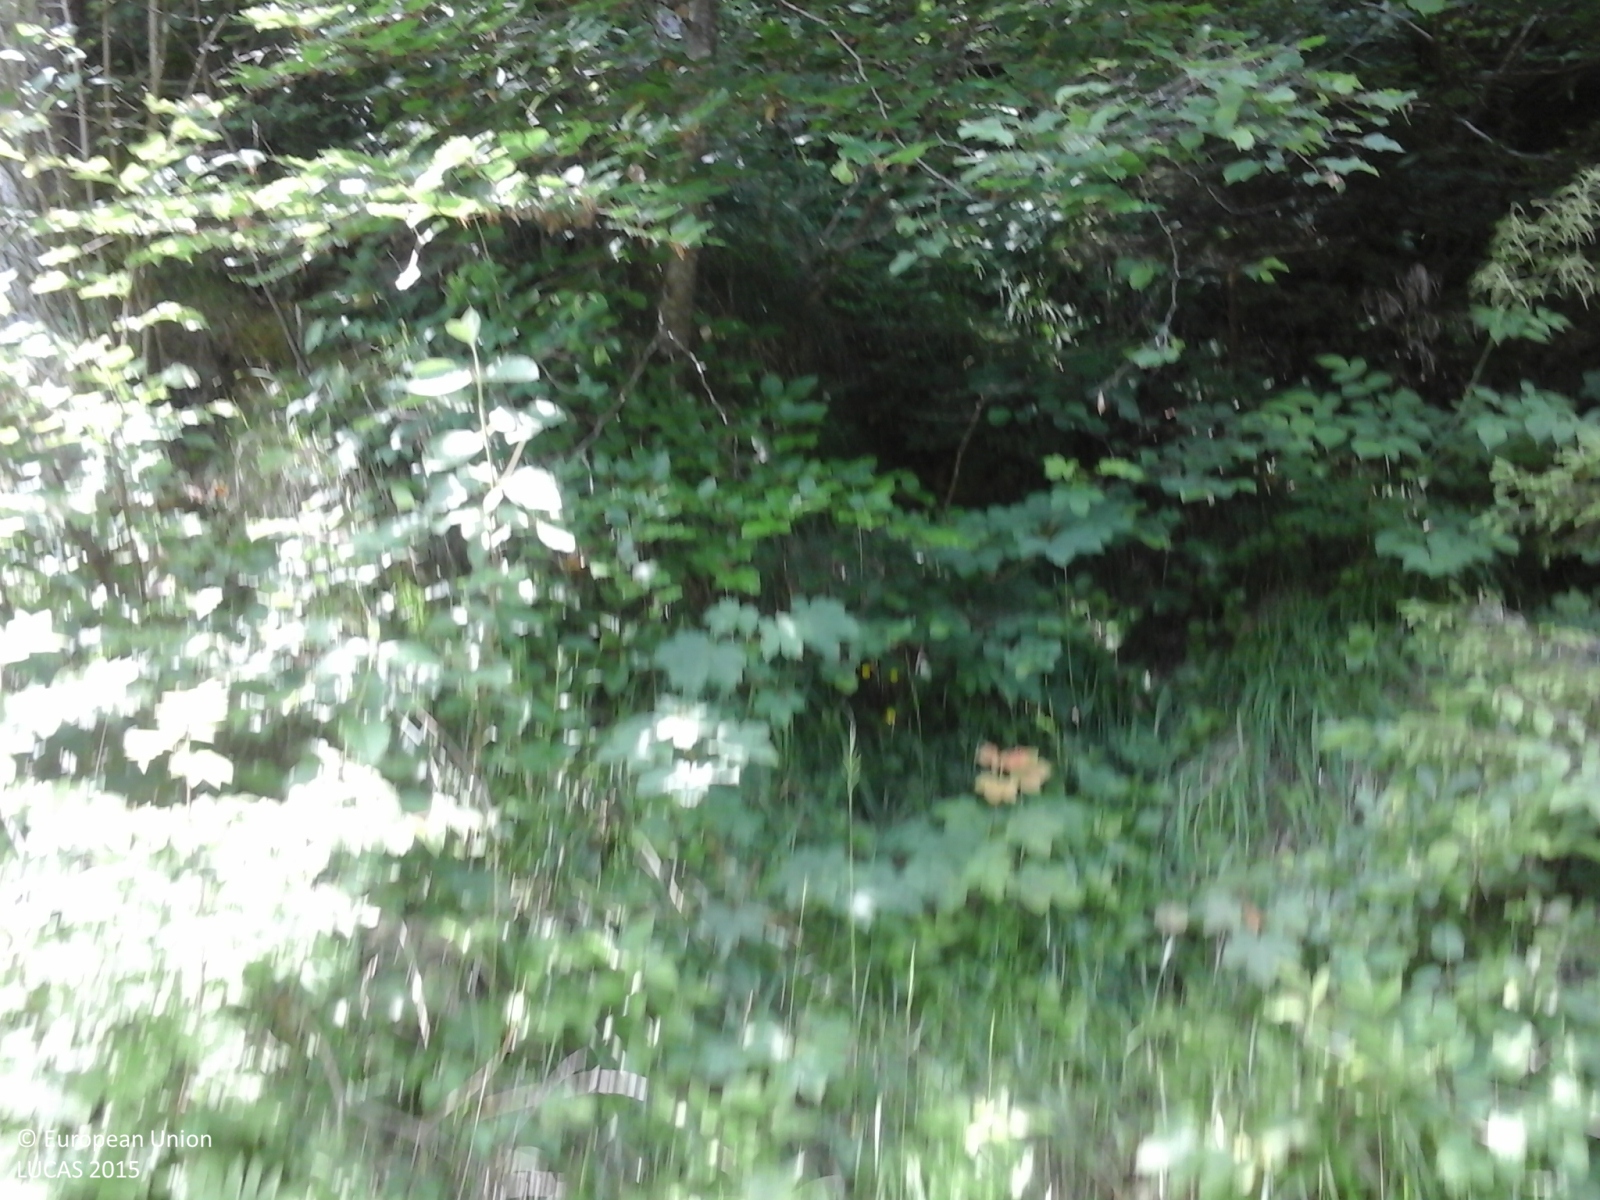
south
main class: Woodland
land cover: Spruce dominated mixed woodland
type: alpine coniferous forest
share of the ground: > 75 %
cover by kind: coniferous forest trees 75 %, broadleaved forest trees 25 %
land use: Semi-natural and natural areas not in use
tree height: > 5 m
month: June
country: IT
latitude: 46.4509
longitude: 12.3797
